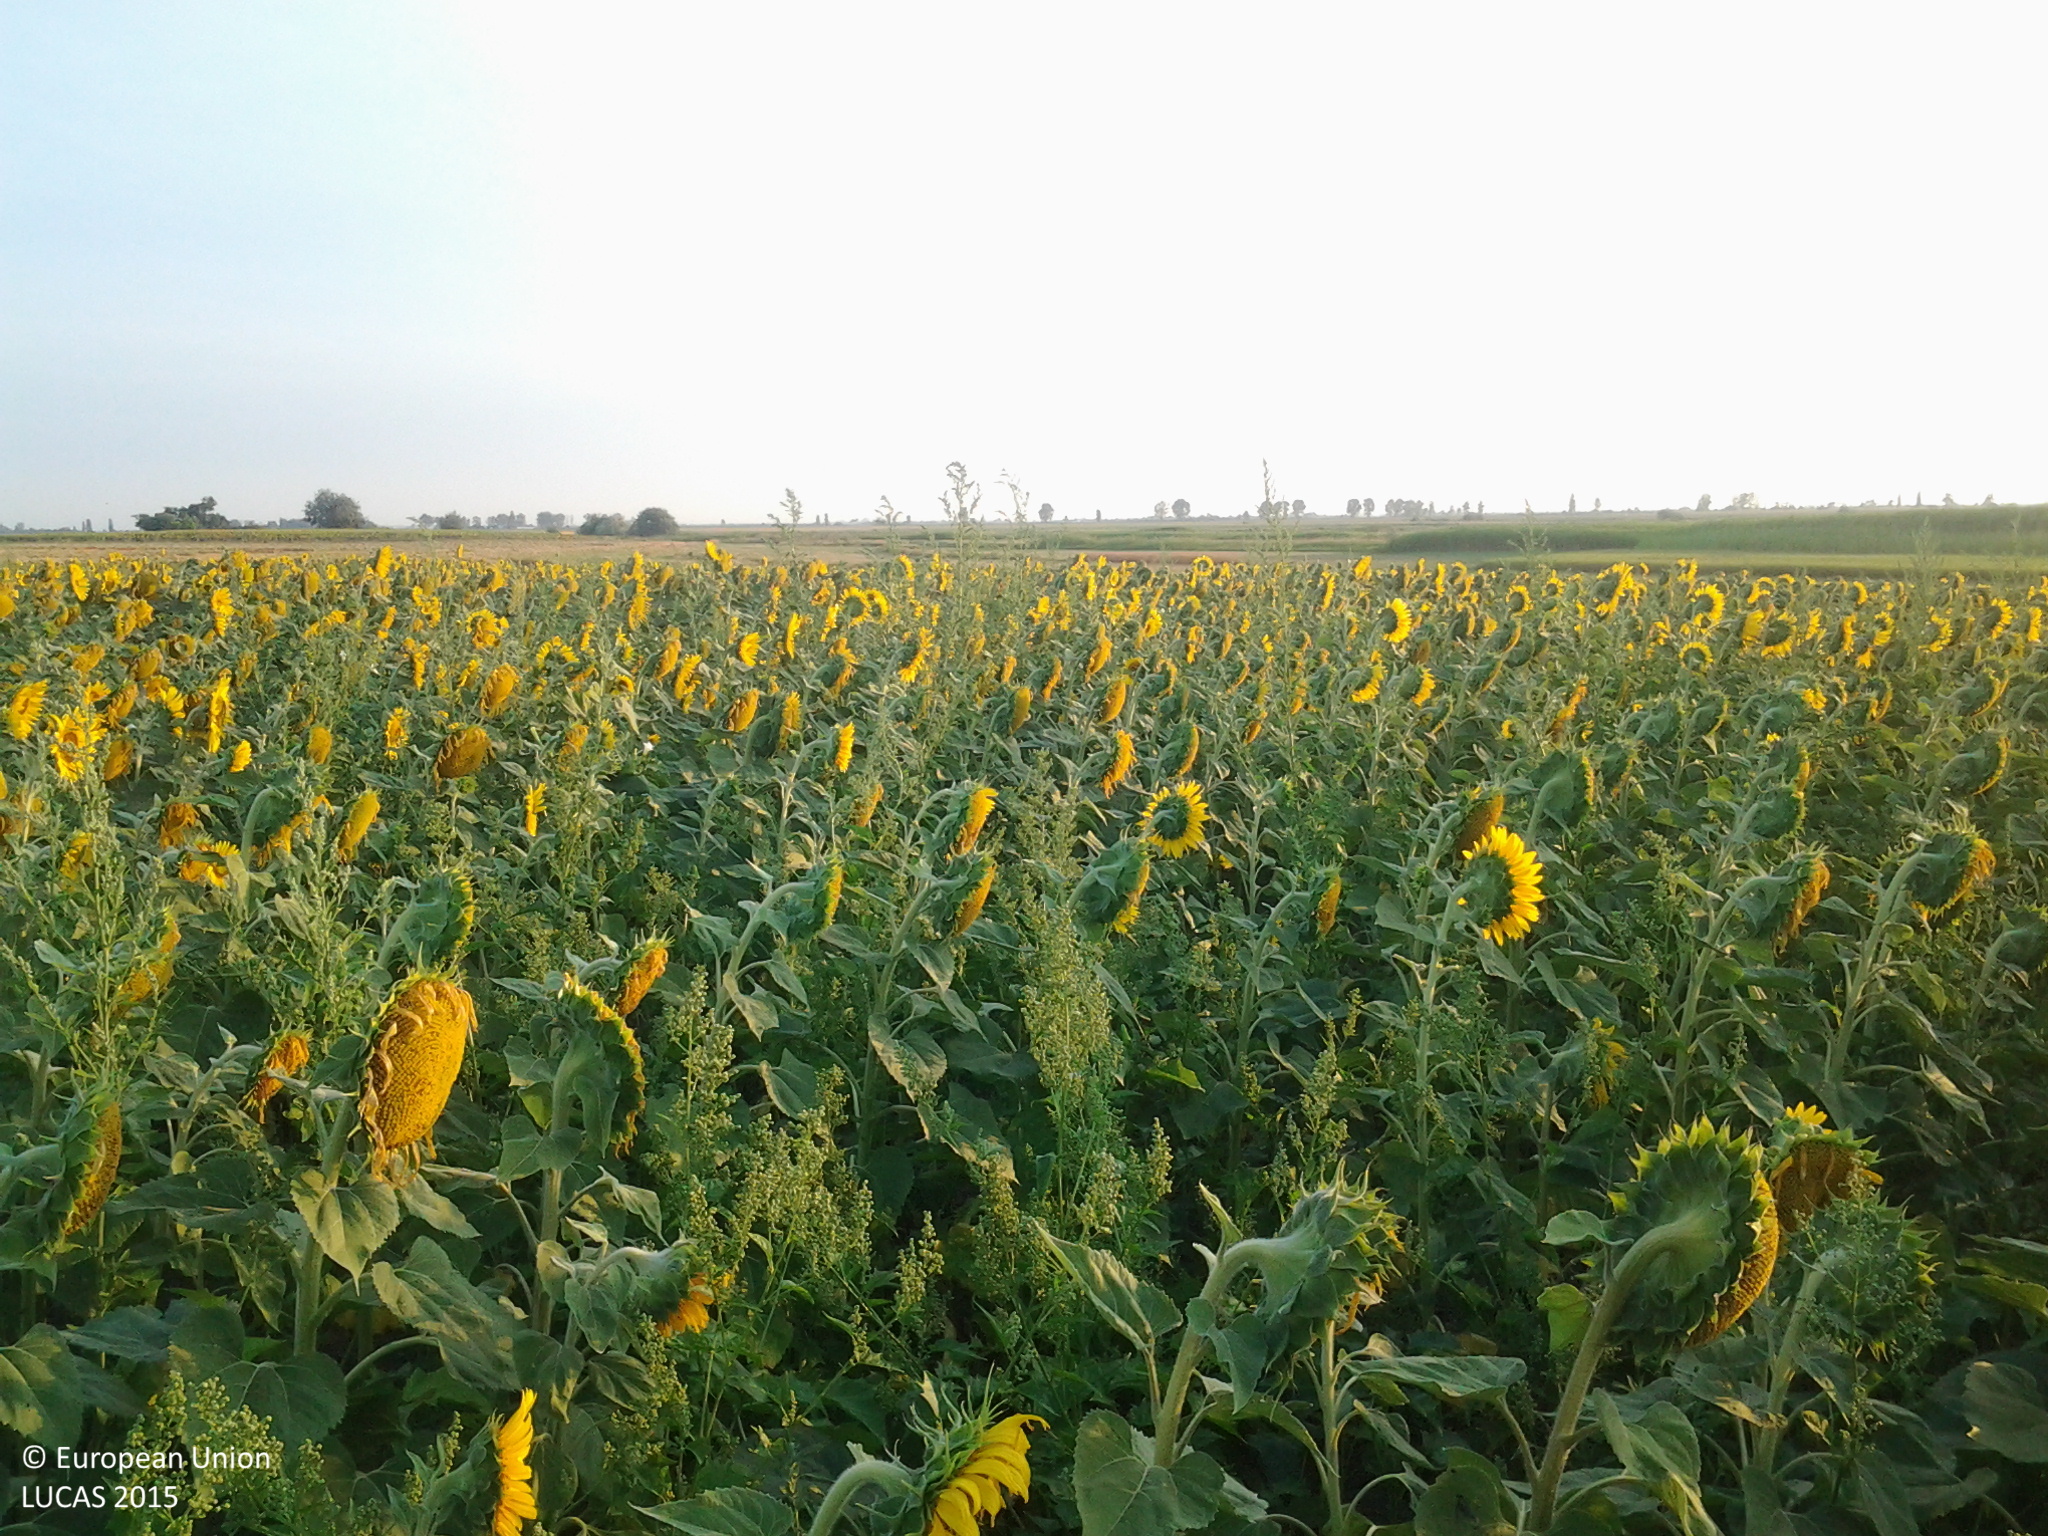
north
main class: Cropland
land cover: Sunflower
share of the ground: > 75 %
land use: Agriculture (excluding fallow land and kitchen gardens)
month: July
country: HU
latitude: 46.8813
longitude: 19.1625
